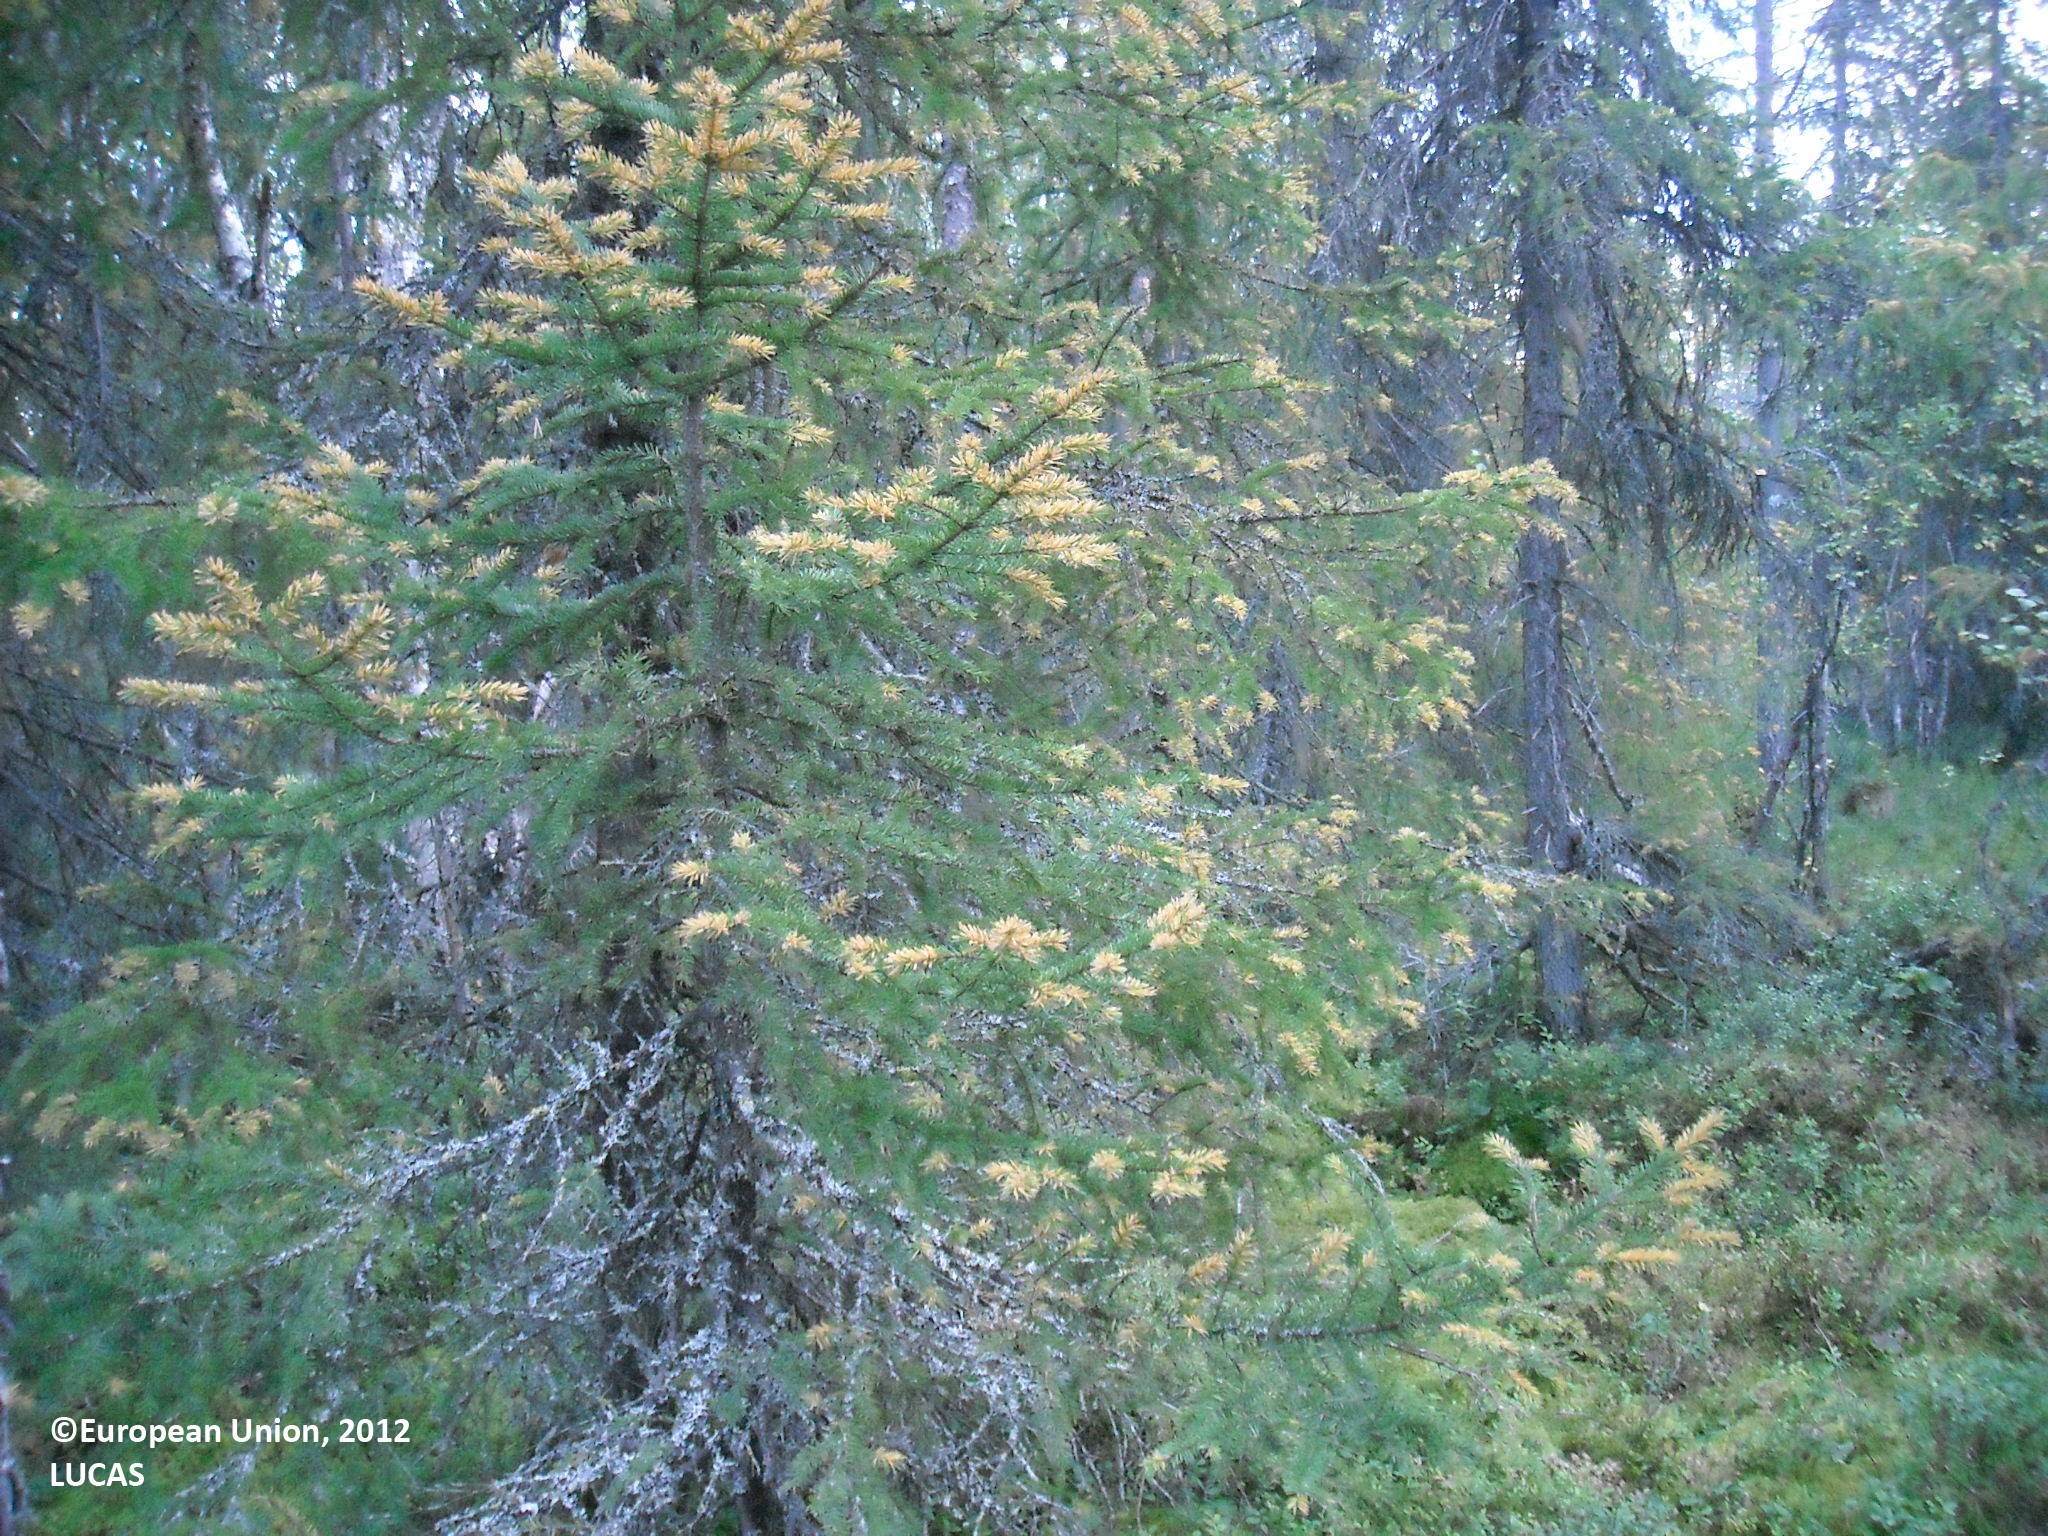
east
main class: Woodland
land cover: Spruce dominated mixed woodland
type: mire and swamp forests
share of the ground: > 75 %
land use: Forestry
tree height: > 5 m
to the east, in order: Spruce dominated mixed woodland; Other mixed woodland; Other coniferous woodland; Other mixed woodland; Ditches and canals; Pine dominated mixed woodland; Pine dominated coniferous woodland
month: August
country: FI
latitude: 65.4345
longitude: 27.7502
